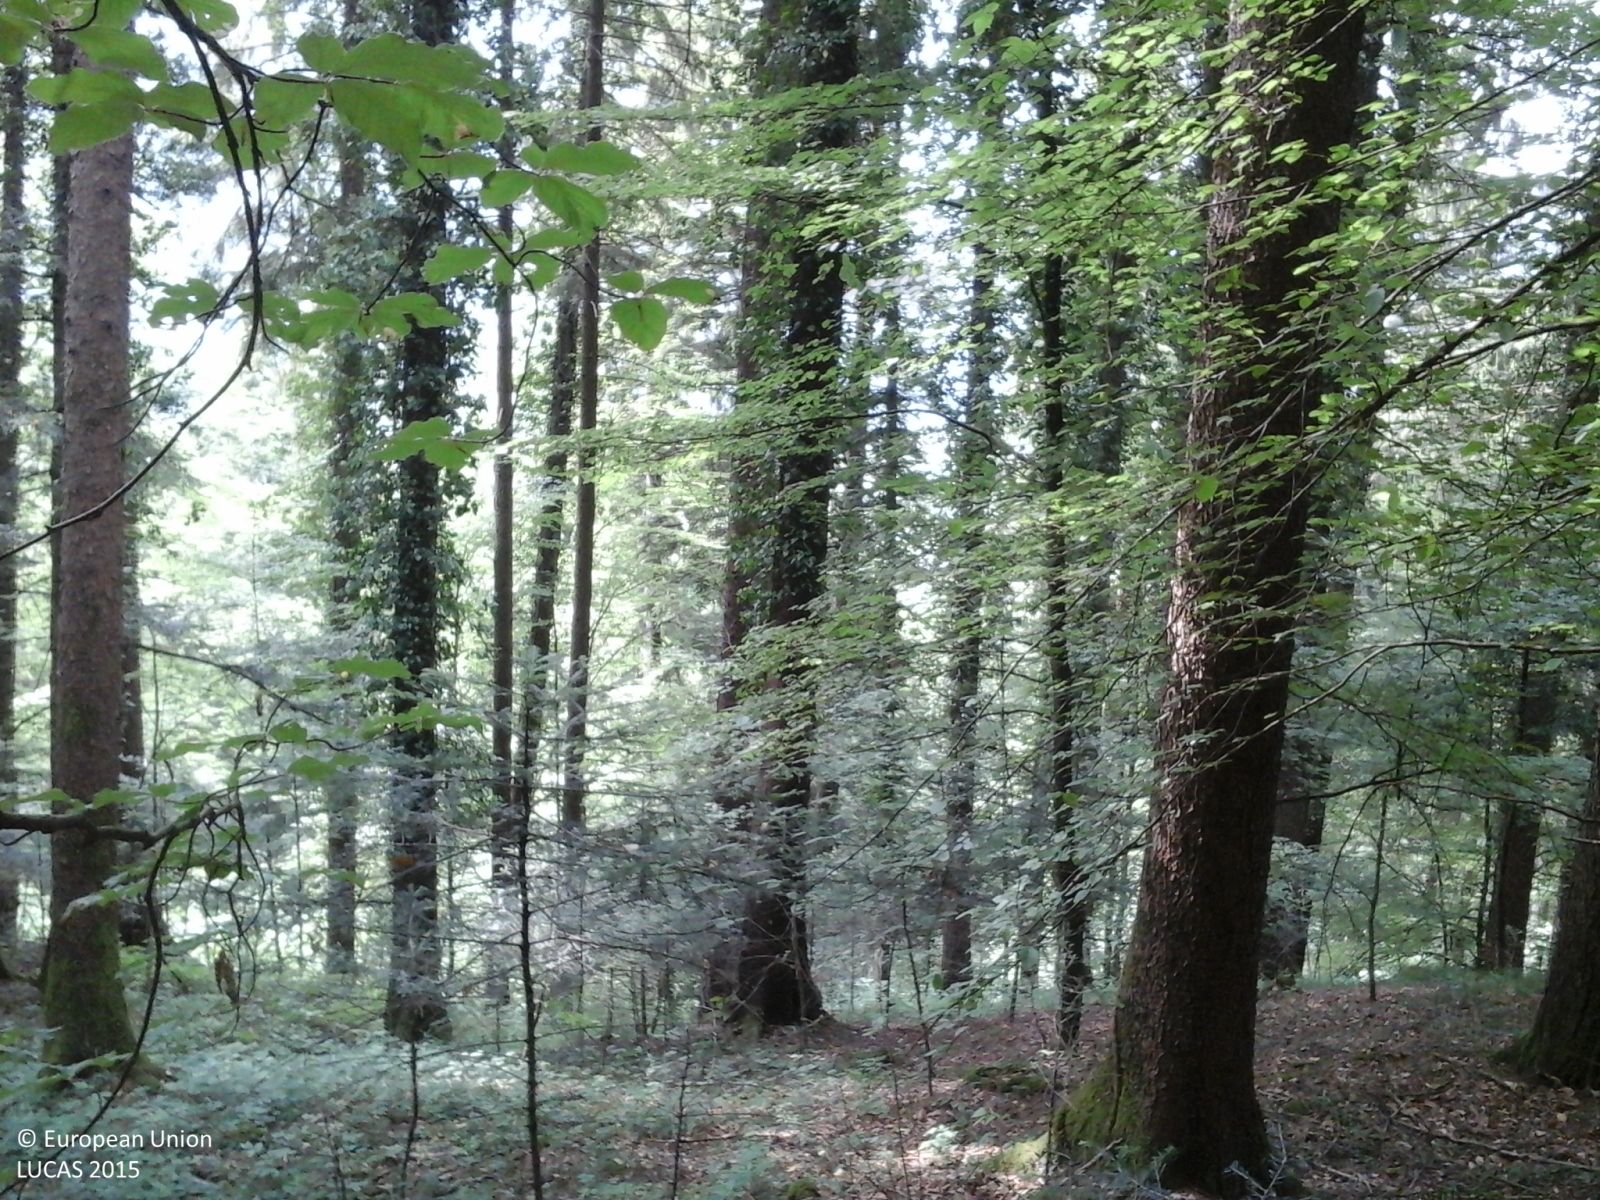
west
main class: Woodland
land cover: Other coniferous woodland
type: alpine coniferous forest
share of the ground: > 75 %
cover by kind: coniferous forest trees 95 %, broadleaved forest trees 5 %
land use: Forestry
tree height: > 5 m
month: June
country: IT
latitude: 45.9876
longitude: 10.8379
